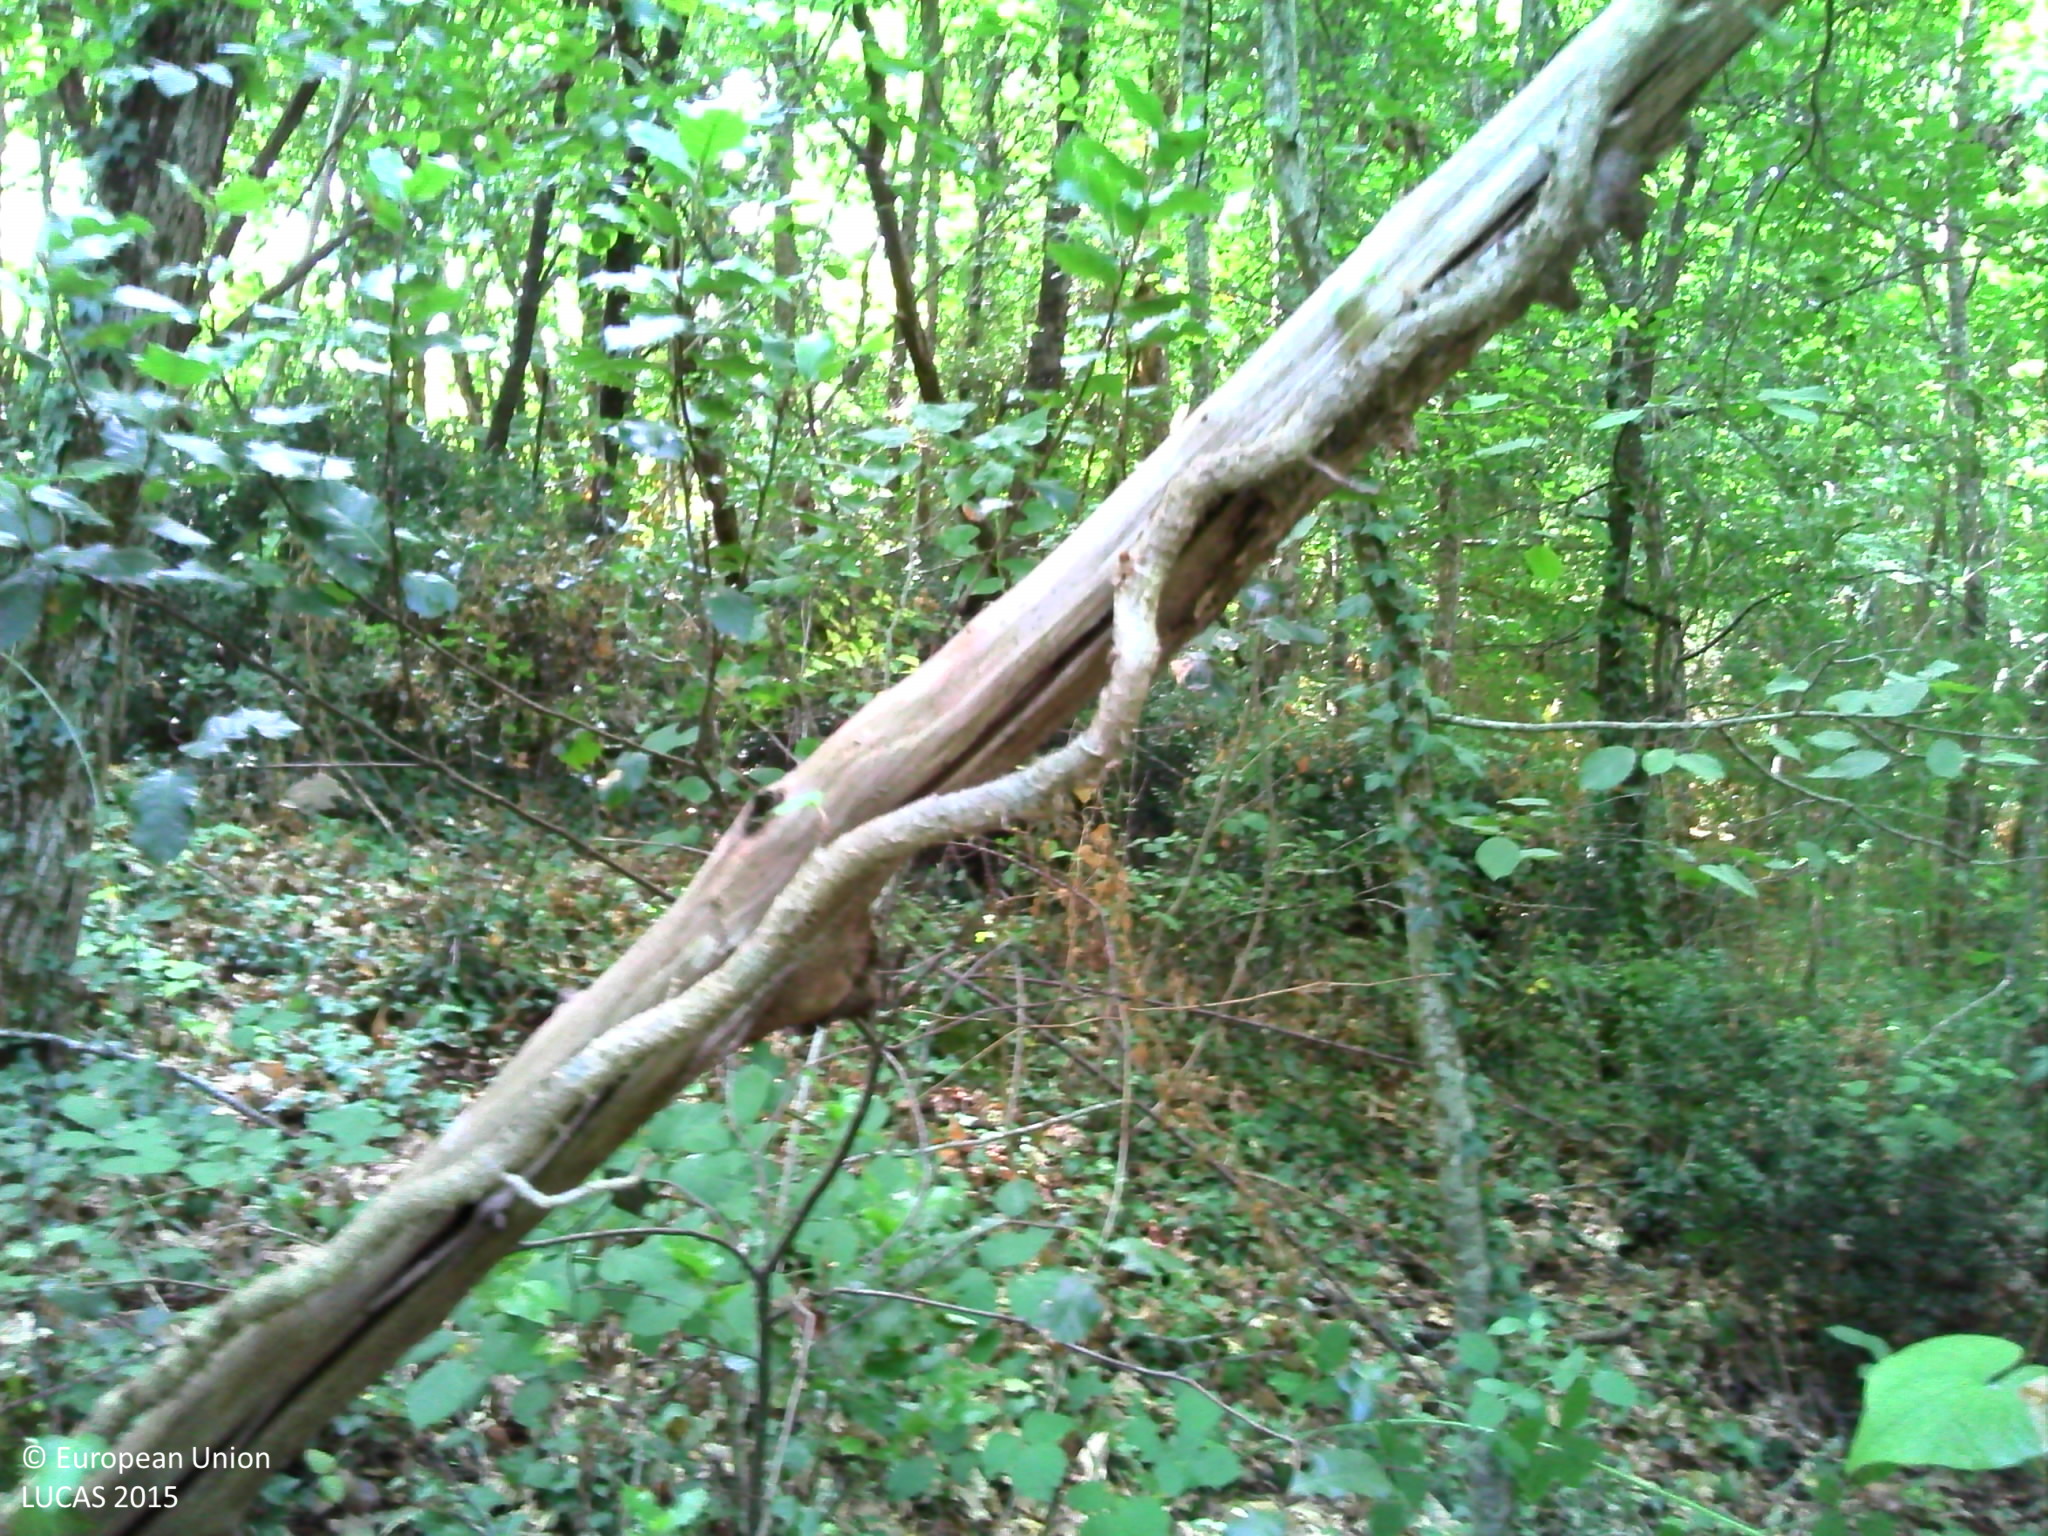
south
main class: Woodland
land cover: Broadleaved woodland
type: thermophilous deciduous forest
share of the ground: > 75 %
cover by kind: broadleaved forest trees 75 %, herbaceous plants 15 %, shrubs 5 %, lichens and mosses 5 %
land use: Forestry
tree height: > 5 m
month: July
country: FR
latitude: 44.8644
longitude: 1.1988
